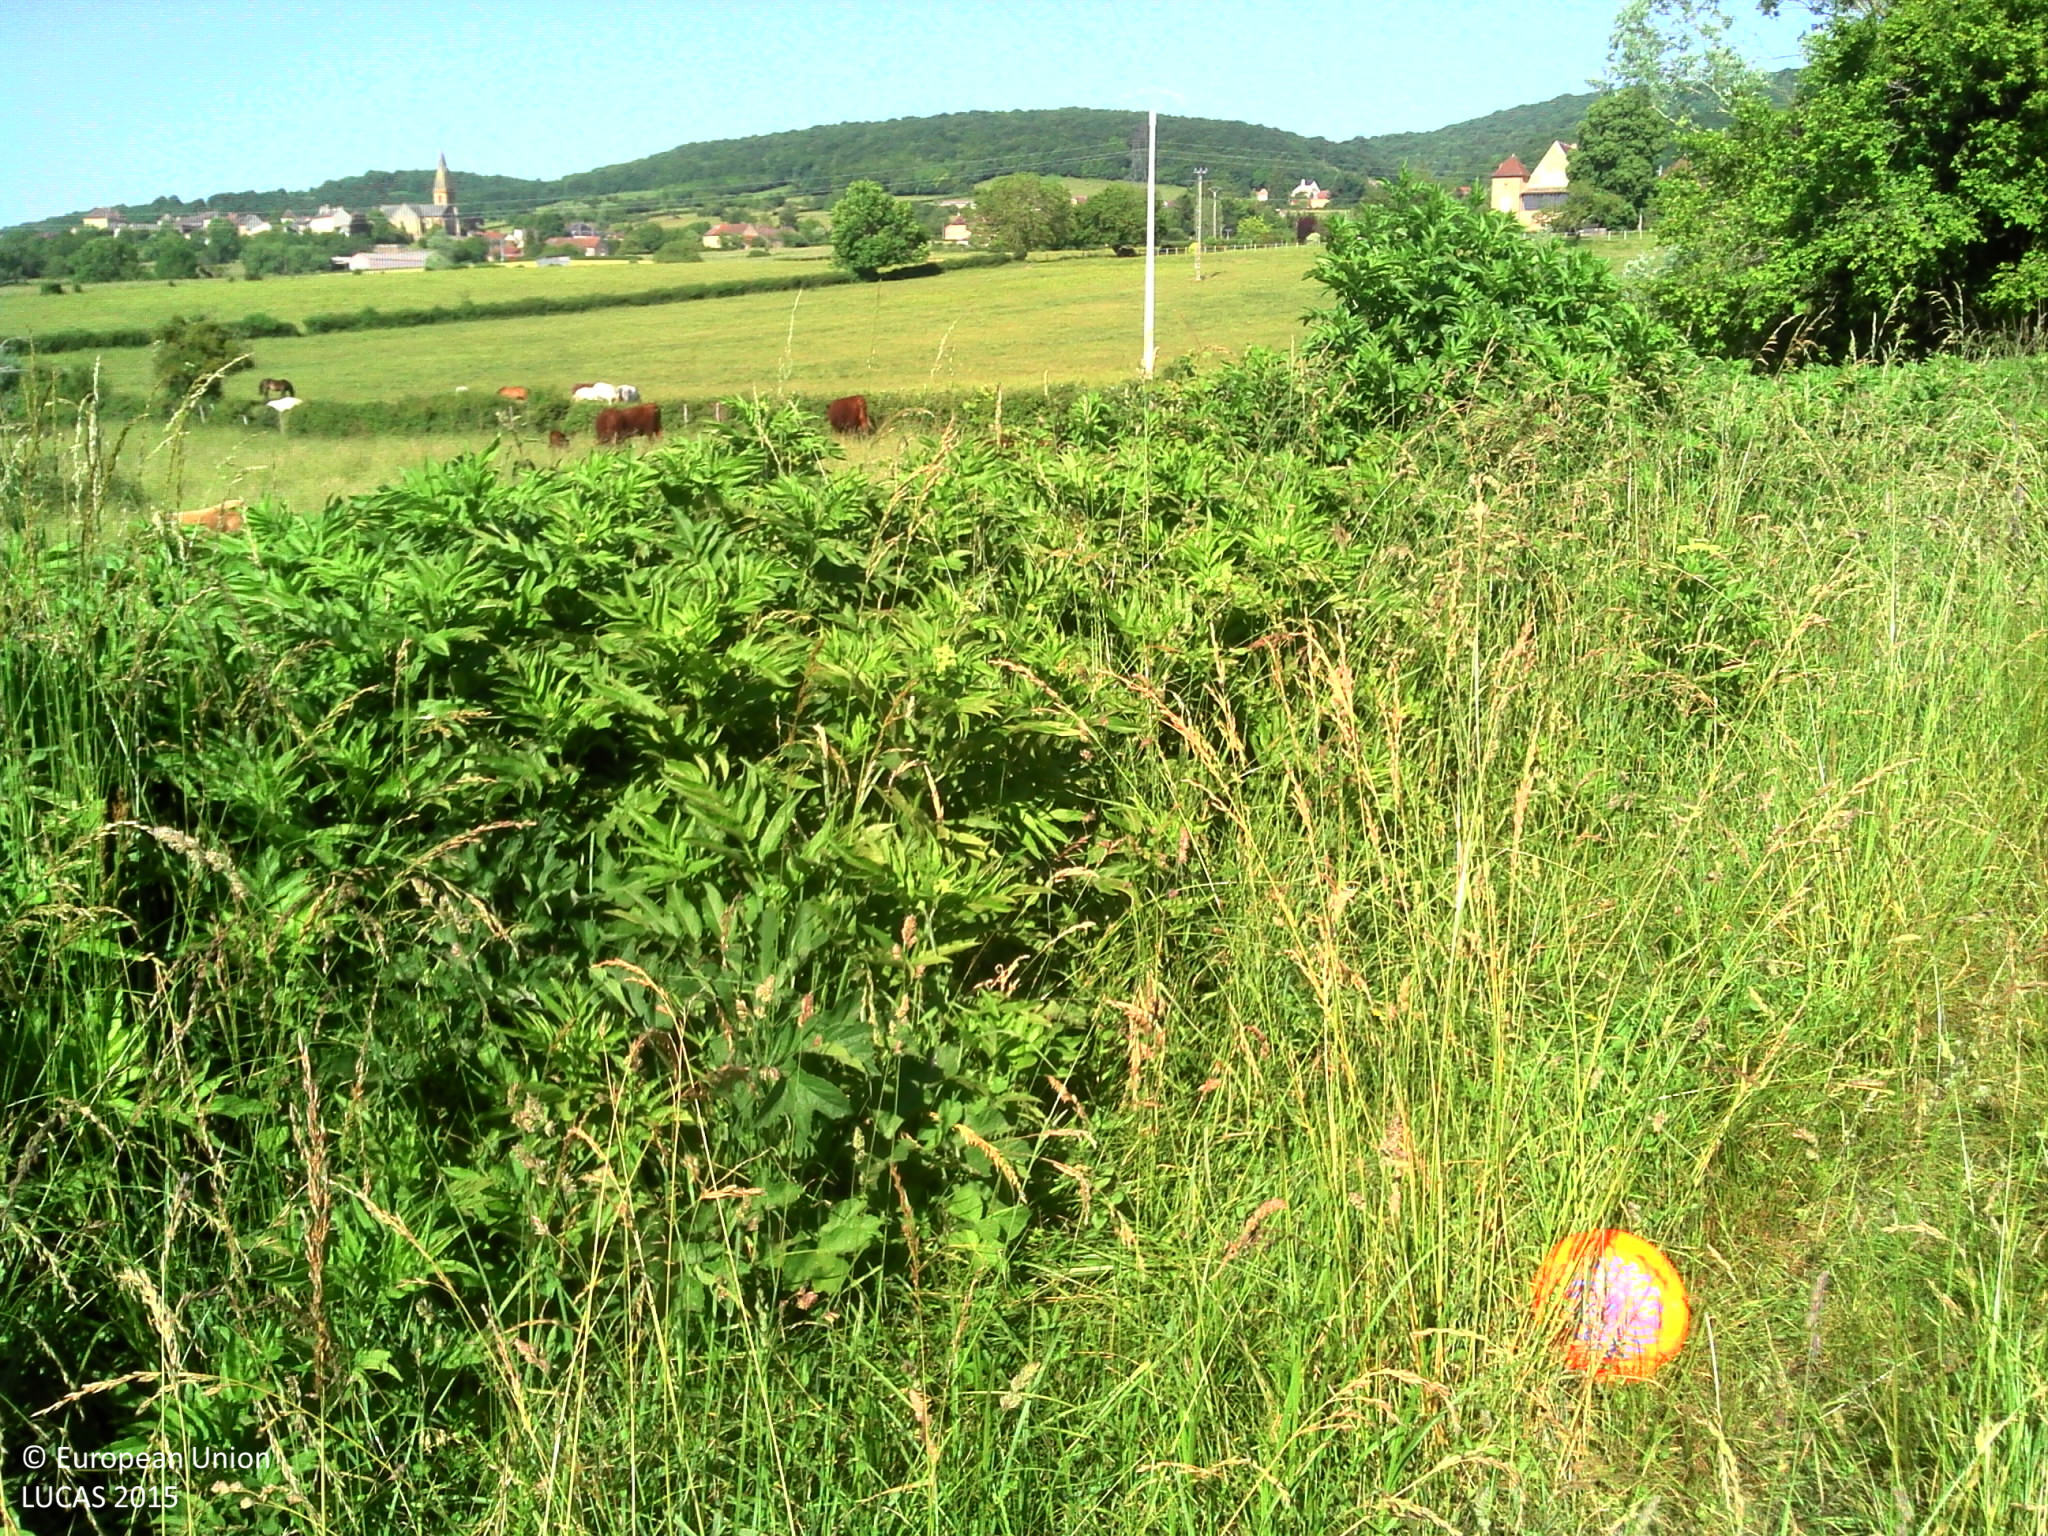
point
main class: Grassland
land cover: Grassland without tree/shrub cover
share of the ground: > 75 %
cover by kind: herbaceous plants 85 %, unconsolidated bare surface 15 %
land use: Agriculture (excluding fallow land and kitchen gardens)
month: June
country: FR
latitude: 46.5854
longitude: 4.7944
